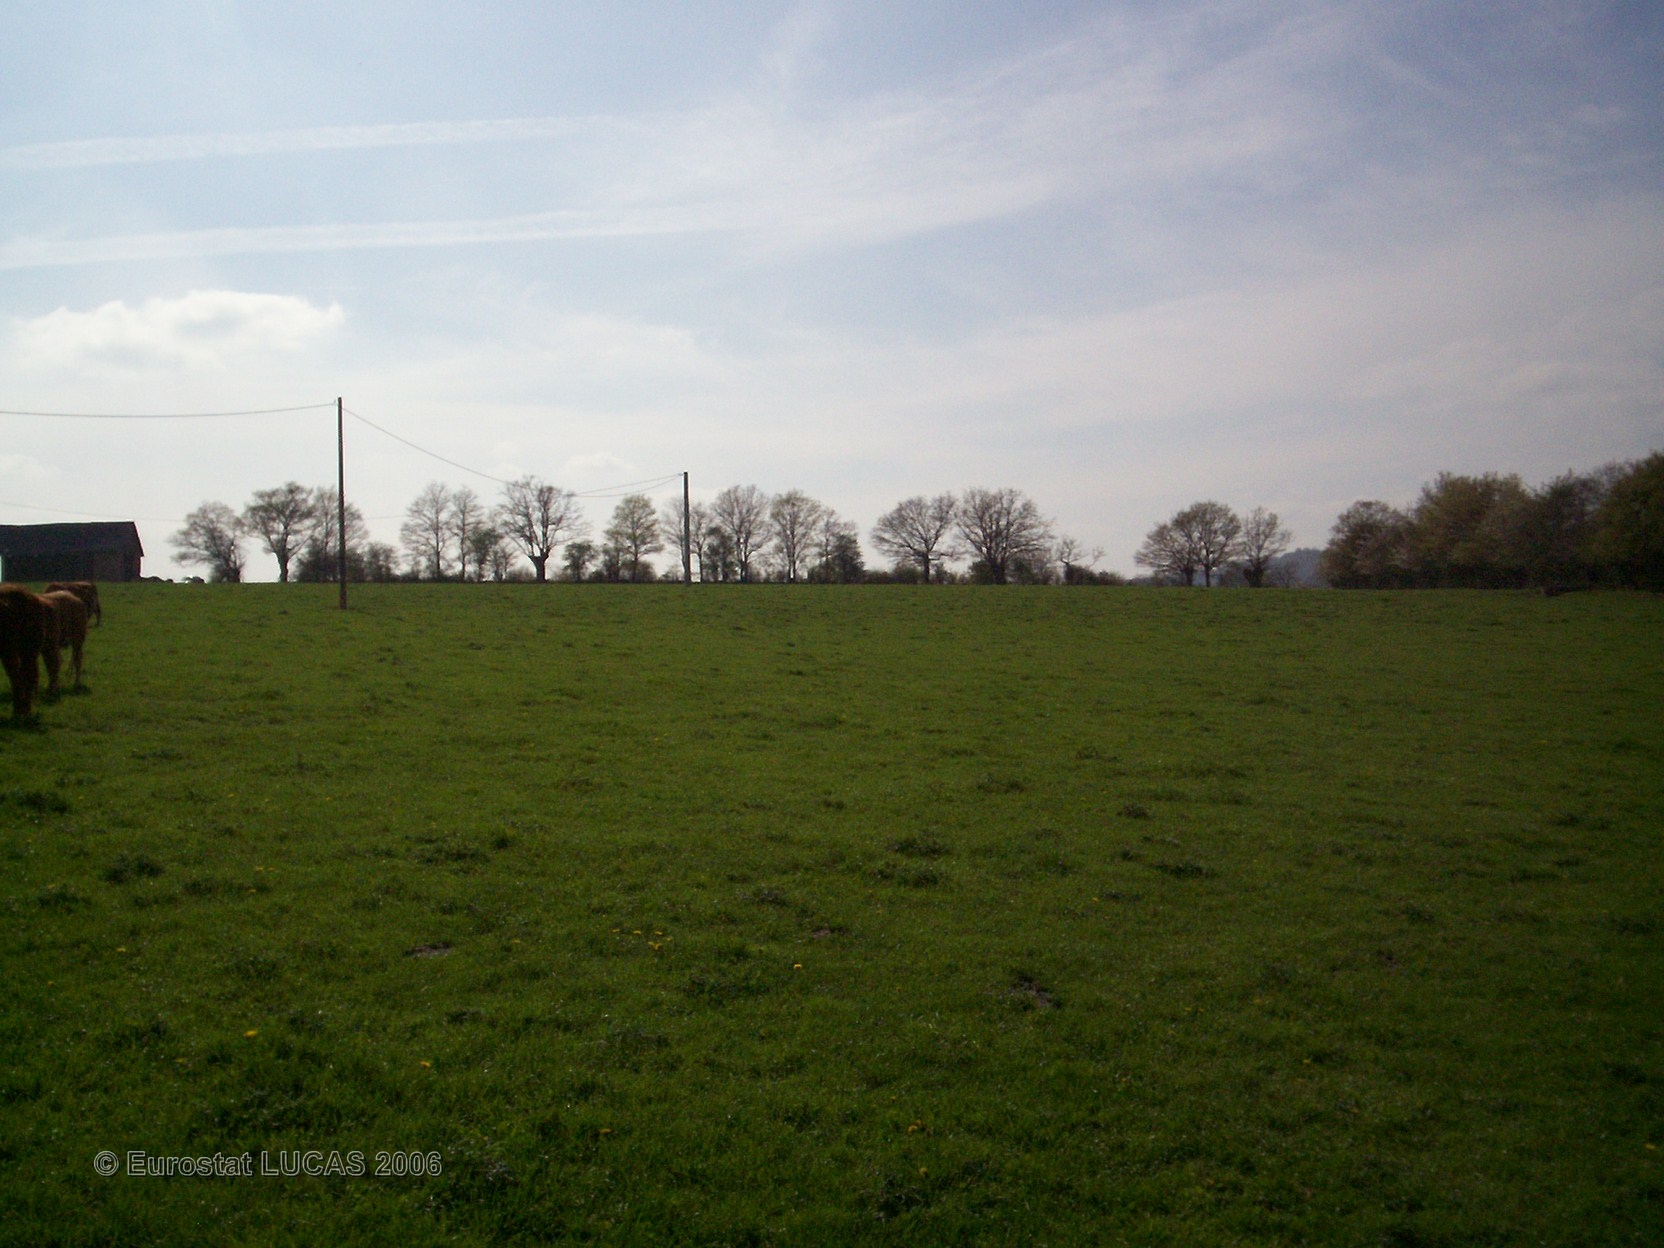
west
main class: Grassland
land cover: Grassland without tree/shrub cover
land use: Agriculture (excluding fallow land and kitchen gardens)
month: April
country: FR
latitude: 48.1452
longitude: -0.2320
